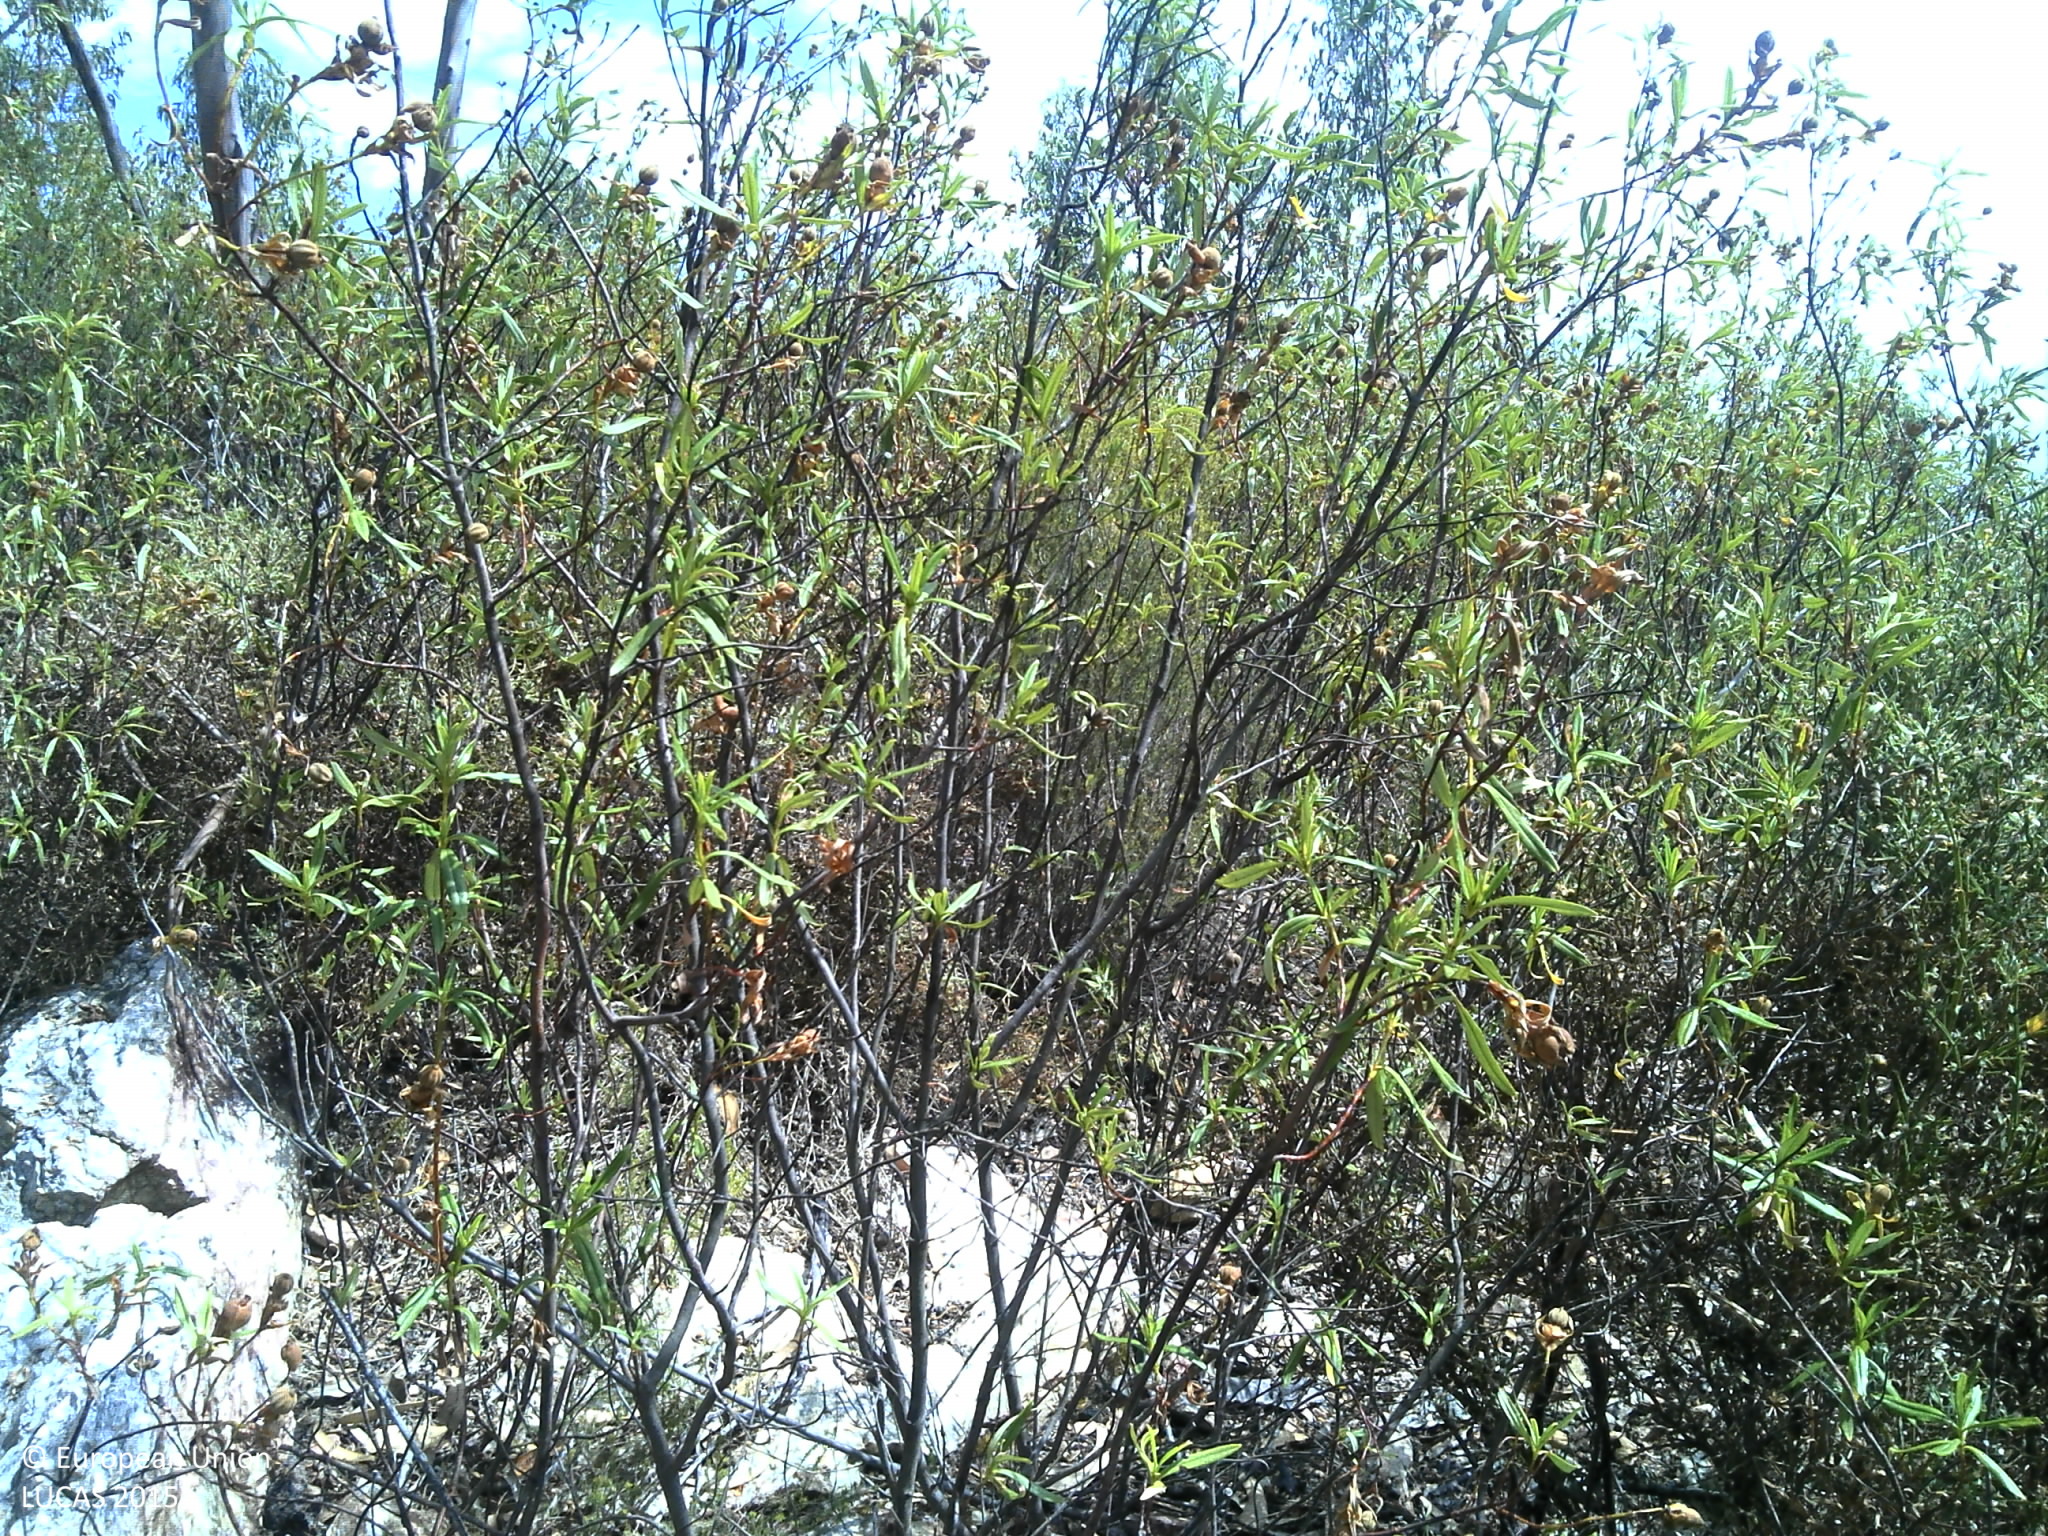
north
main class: Shrubland
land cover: Shrubland with sparse tree cover
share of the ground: > 75 %
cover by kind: shrubs 90 %, broadleaved forest trees 5 %, unconsolidated bare surface 5 %
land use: Abandoned areas
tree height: > 5 m
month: July
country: PT
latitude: 39.5148
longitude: -8.0786
